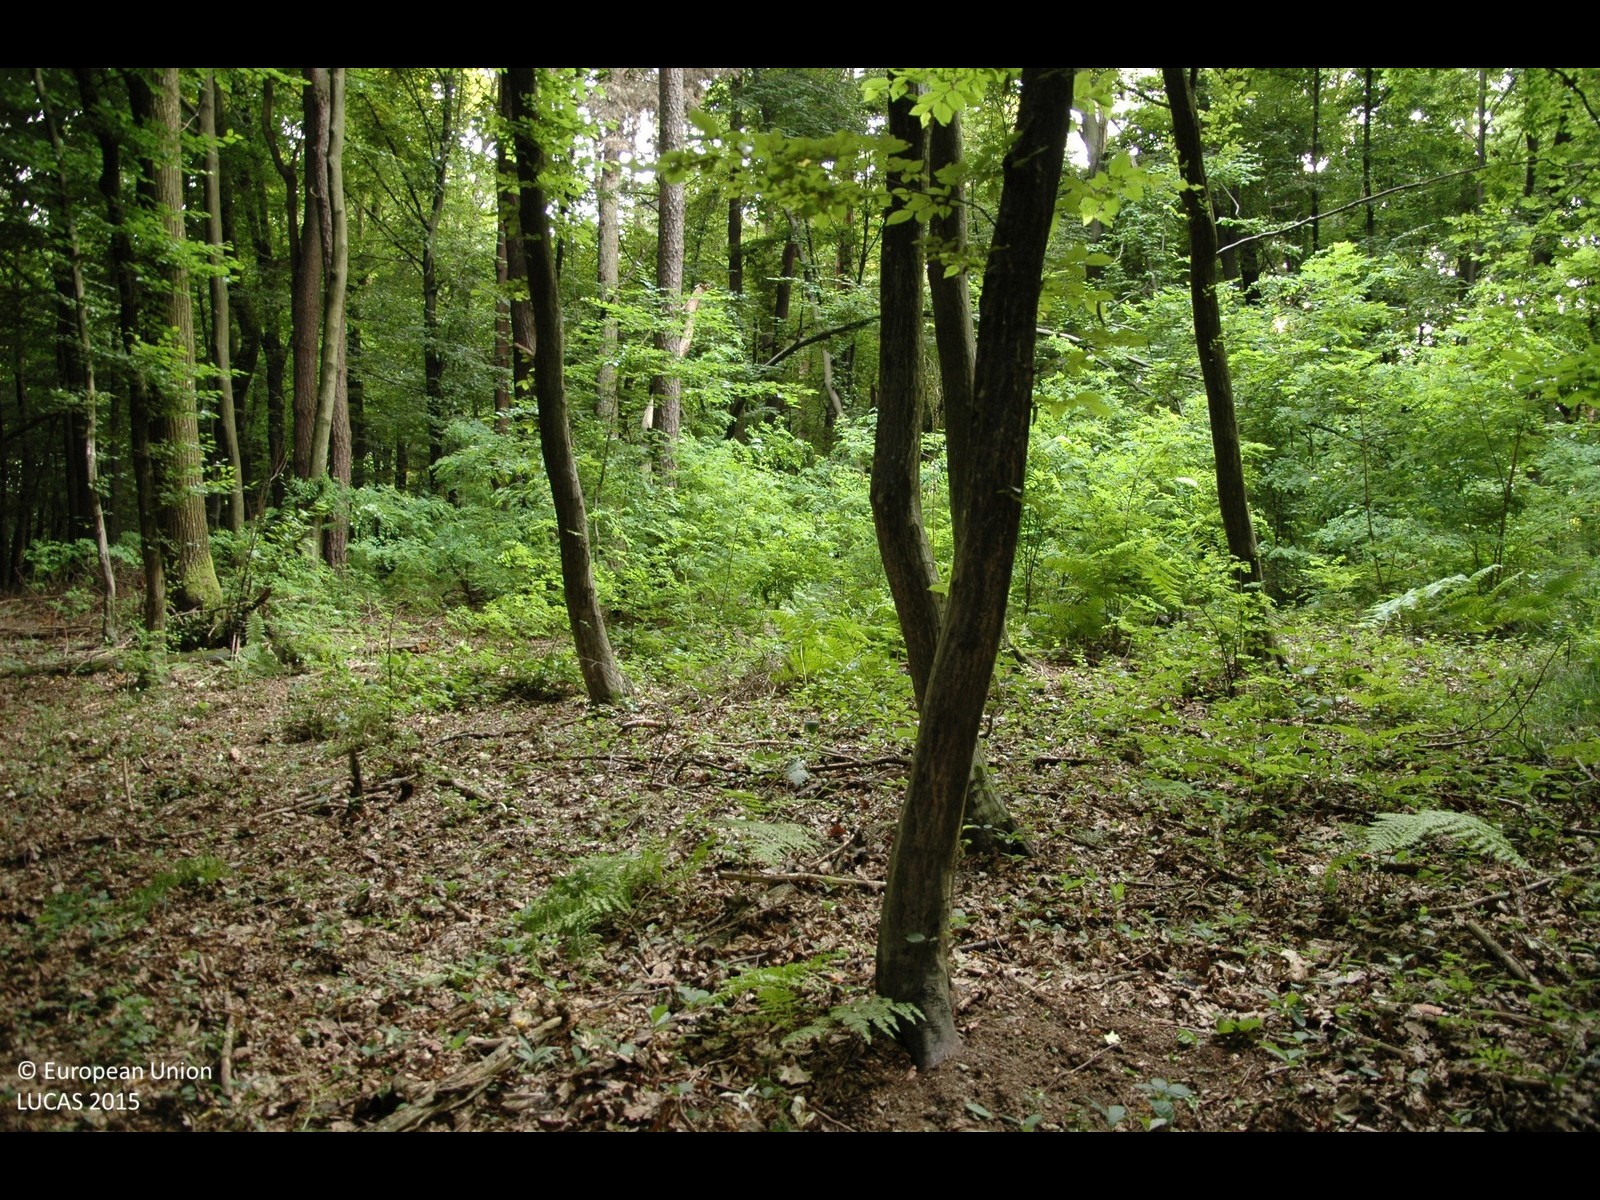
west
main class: Woodland
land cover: Broadleaved woodland
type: mesophytic deciduous forest
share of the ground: > 75 %
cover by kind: broadleaved forest trees 100 %
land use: Forestry
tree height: > 5 m
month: June
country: HR
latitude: 46.4357
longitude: 16.3127
